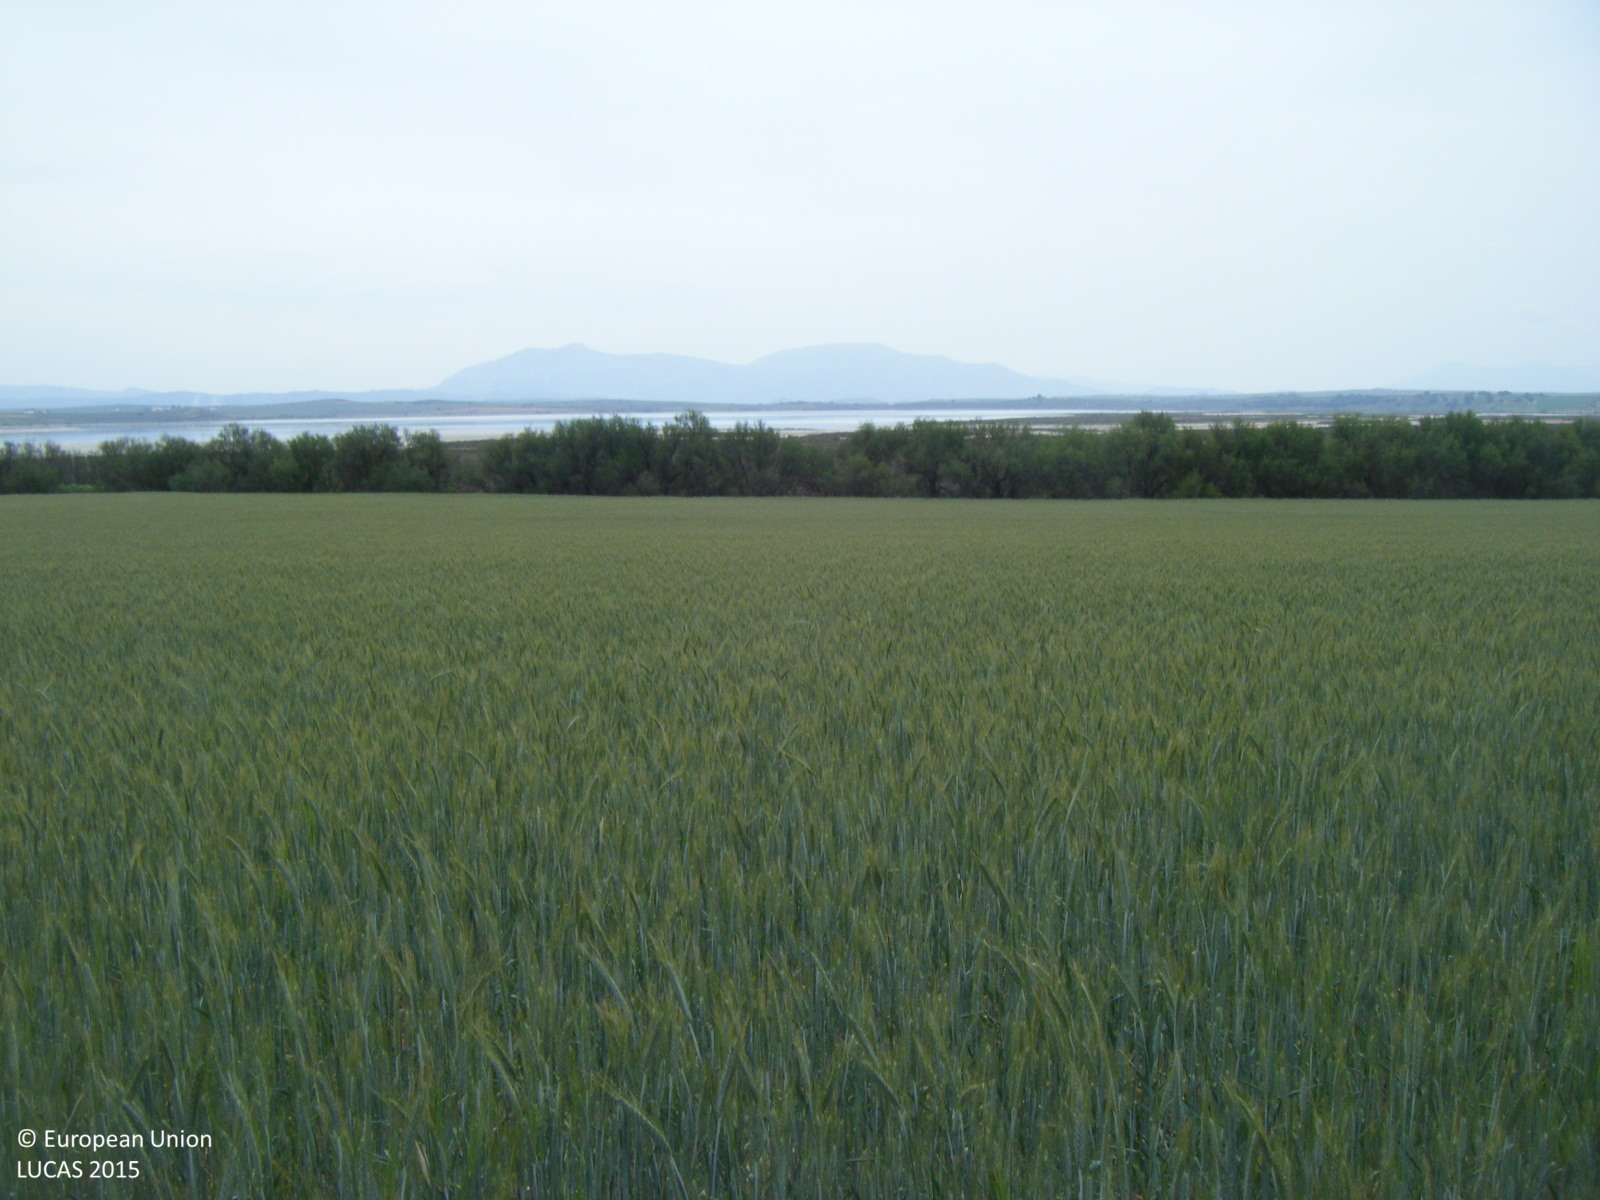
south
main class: Shrubland
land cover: Shrubland without tree cover
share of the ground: > 75 %
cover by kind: shrubs 80 %, herbaceous plants 20 %
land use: Semi-natural and natural areas not in use
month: April
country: ES
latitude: 37.1195
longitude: -4.7785
